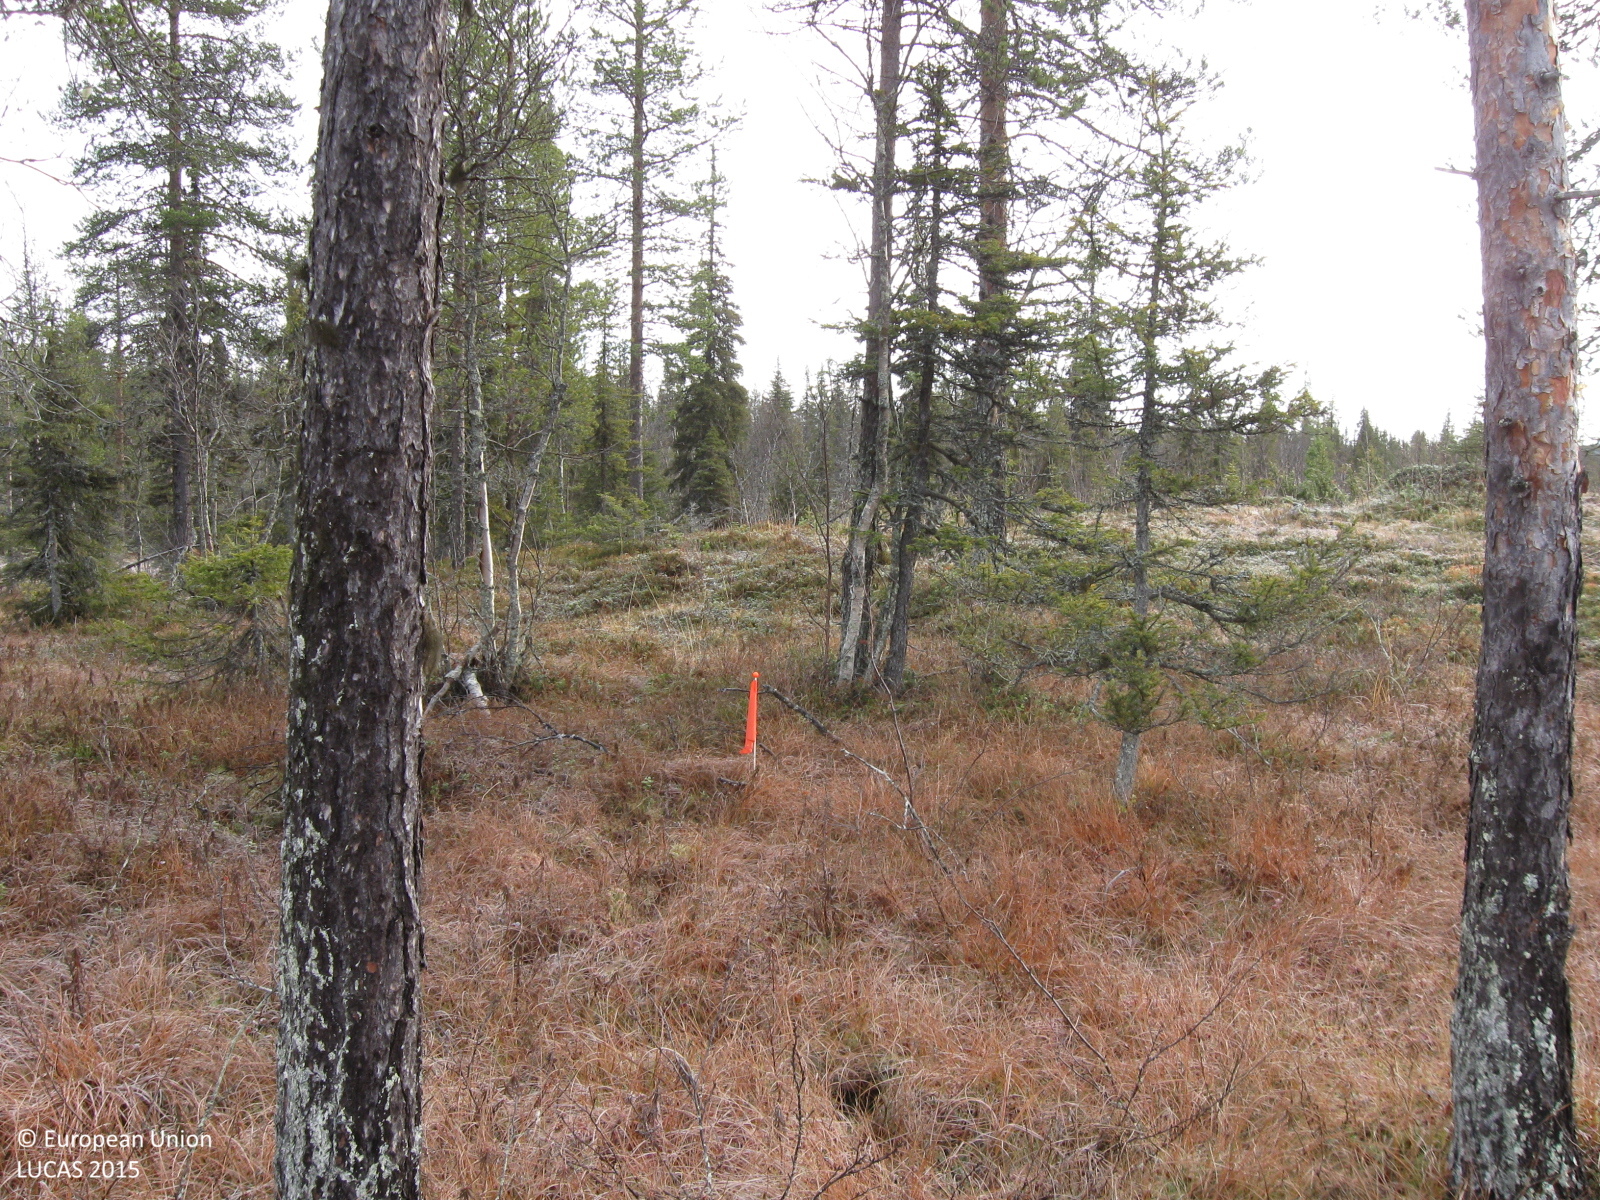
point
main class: Woodland
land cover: Pine dominated coniferous woodland
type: mire and swamp forests
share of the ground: 25 - 50 %
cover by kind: coniferous forest trees 35 %, herbaceous plants 30 %, shrubs 15 %, broadleaved forest trees 10 %, lichens and mosses 10 %
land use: Forestry
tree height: > 5 m
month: October
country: SE
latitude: 66.5031
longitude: 21.5383
